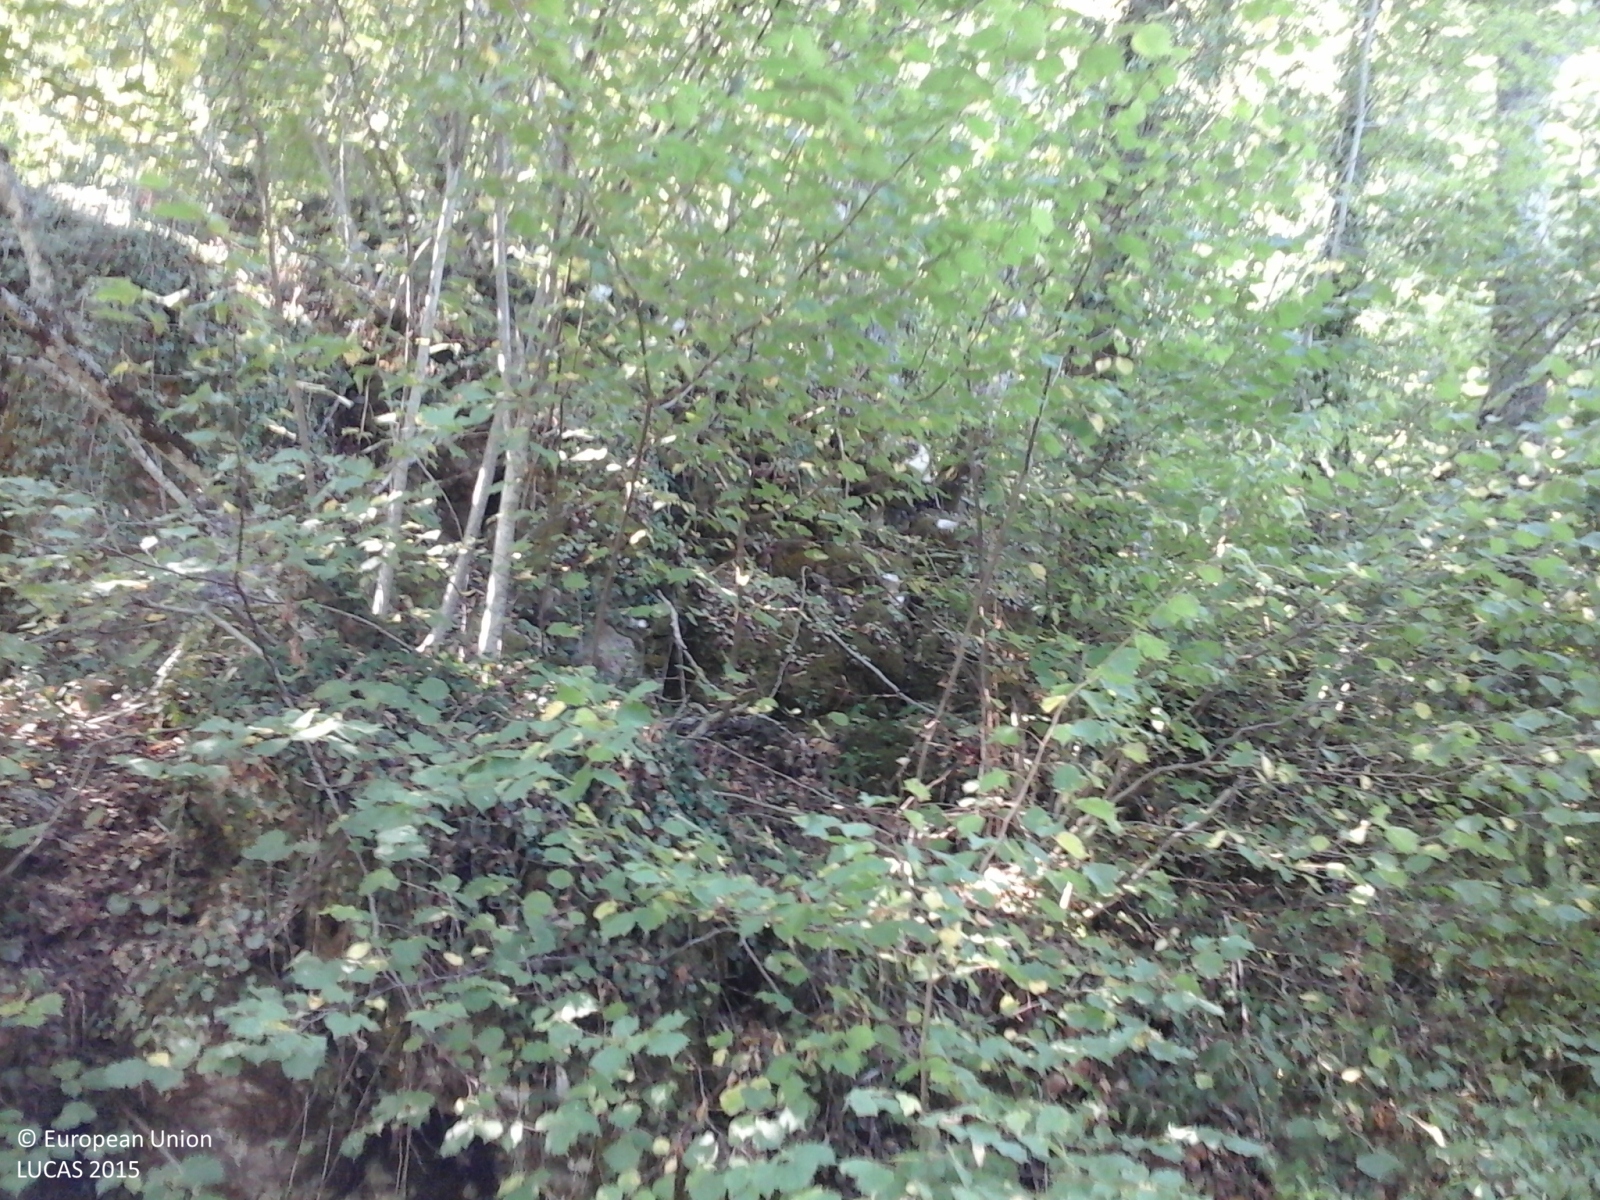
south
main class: Woodland
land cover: Broadleaved woodland
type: thermophilous deciduous forest
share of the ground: > 75 %
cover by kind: broadleaved forest trees 75 %, shrubs 15 %, herbaceous plants 10 %
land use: Semi-natural and natural areas not in use
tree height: > 5 m
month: August
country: IT
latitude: 41.6552
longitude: 14.3677
